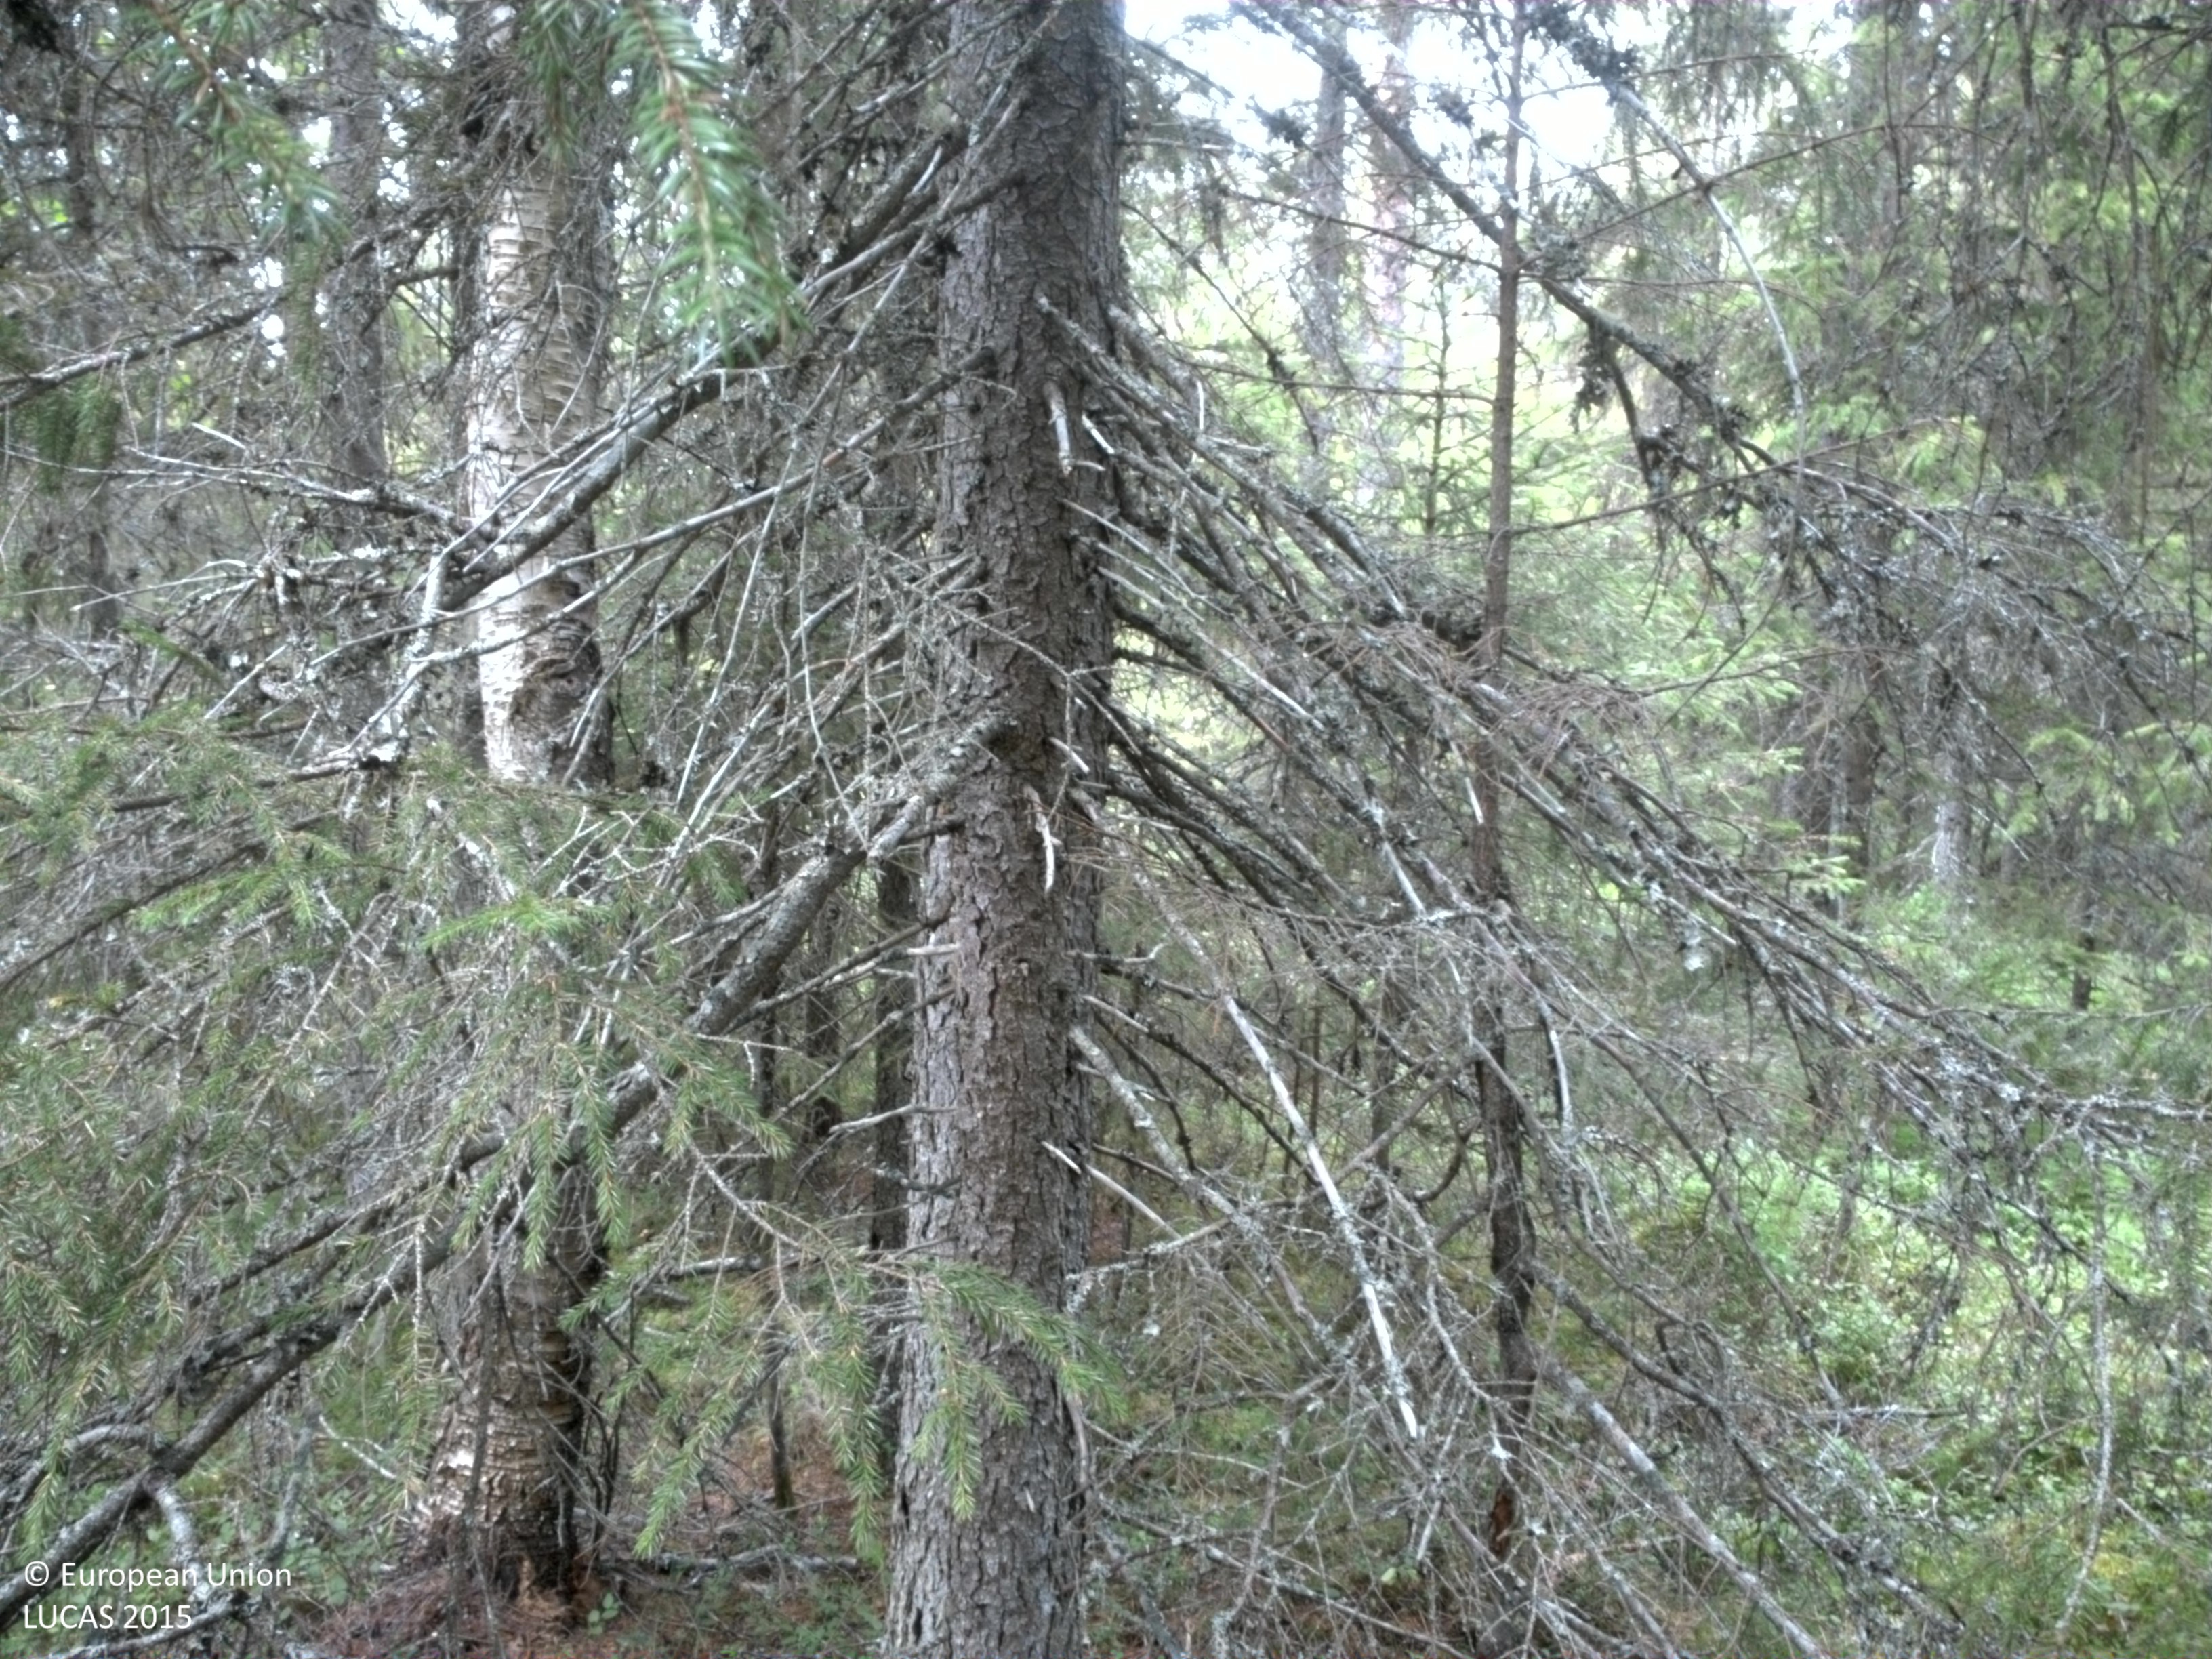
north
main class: Woodland
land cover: Spruce dominated coniferous woodland
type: boreal forest
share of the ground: > 75 %
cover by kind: coniferous forest trees 70 %, shrubs 25 %, broadleaved forest trees 5 %
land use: Forestry
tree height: > 5 m
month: August
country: SE
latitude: 64.5094
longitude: 20.1586
